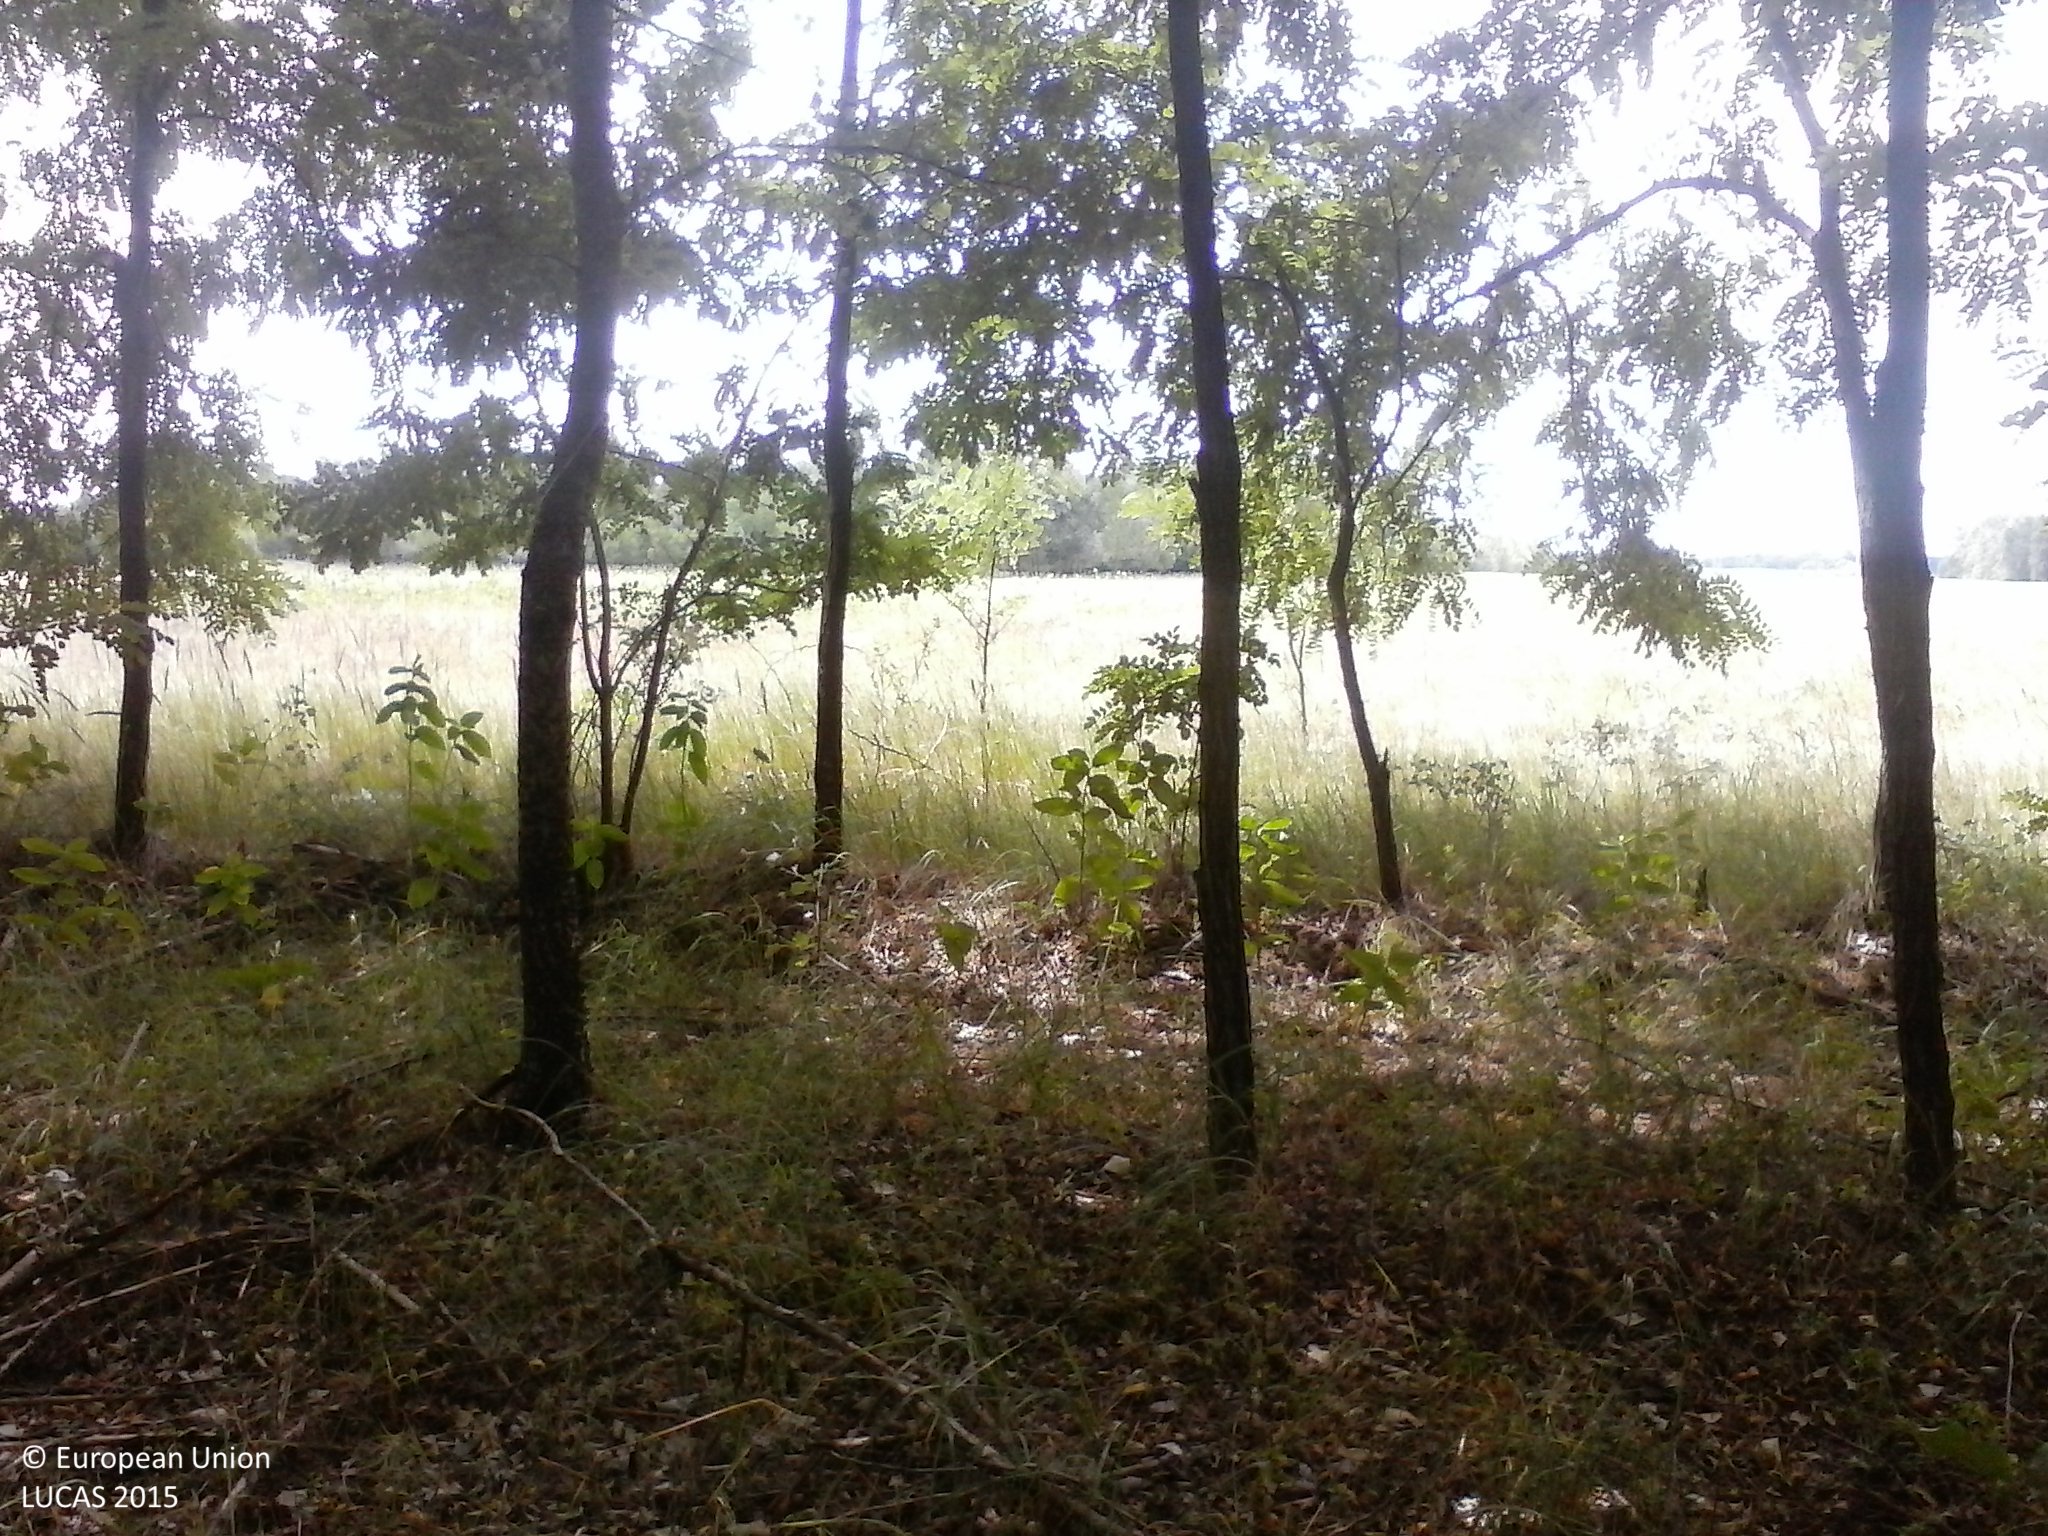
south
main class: Woodland
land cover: Broadleaved woodland
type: mesophytic deciduous forest
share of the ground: > 75 %
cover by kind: broadleaved forest trees 90 %, shrubs 5 %, herbaceous plants 5 %
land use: Forestry
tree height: > 5 m
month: July
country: HU
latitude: 46.6015
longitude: 19.6665
